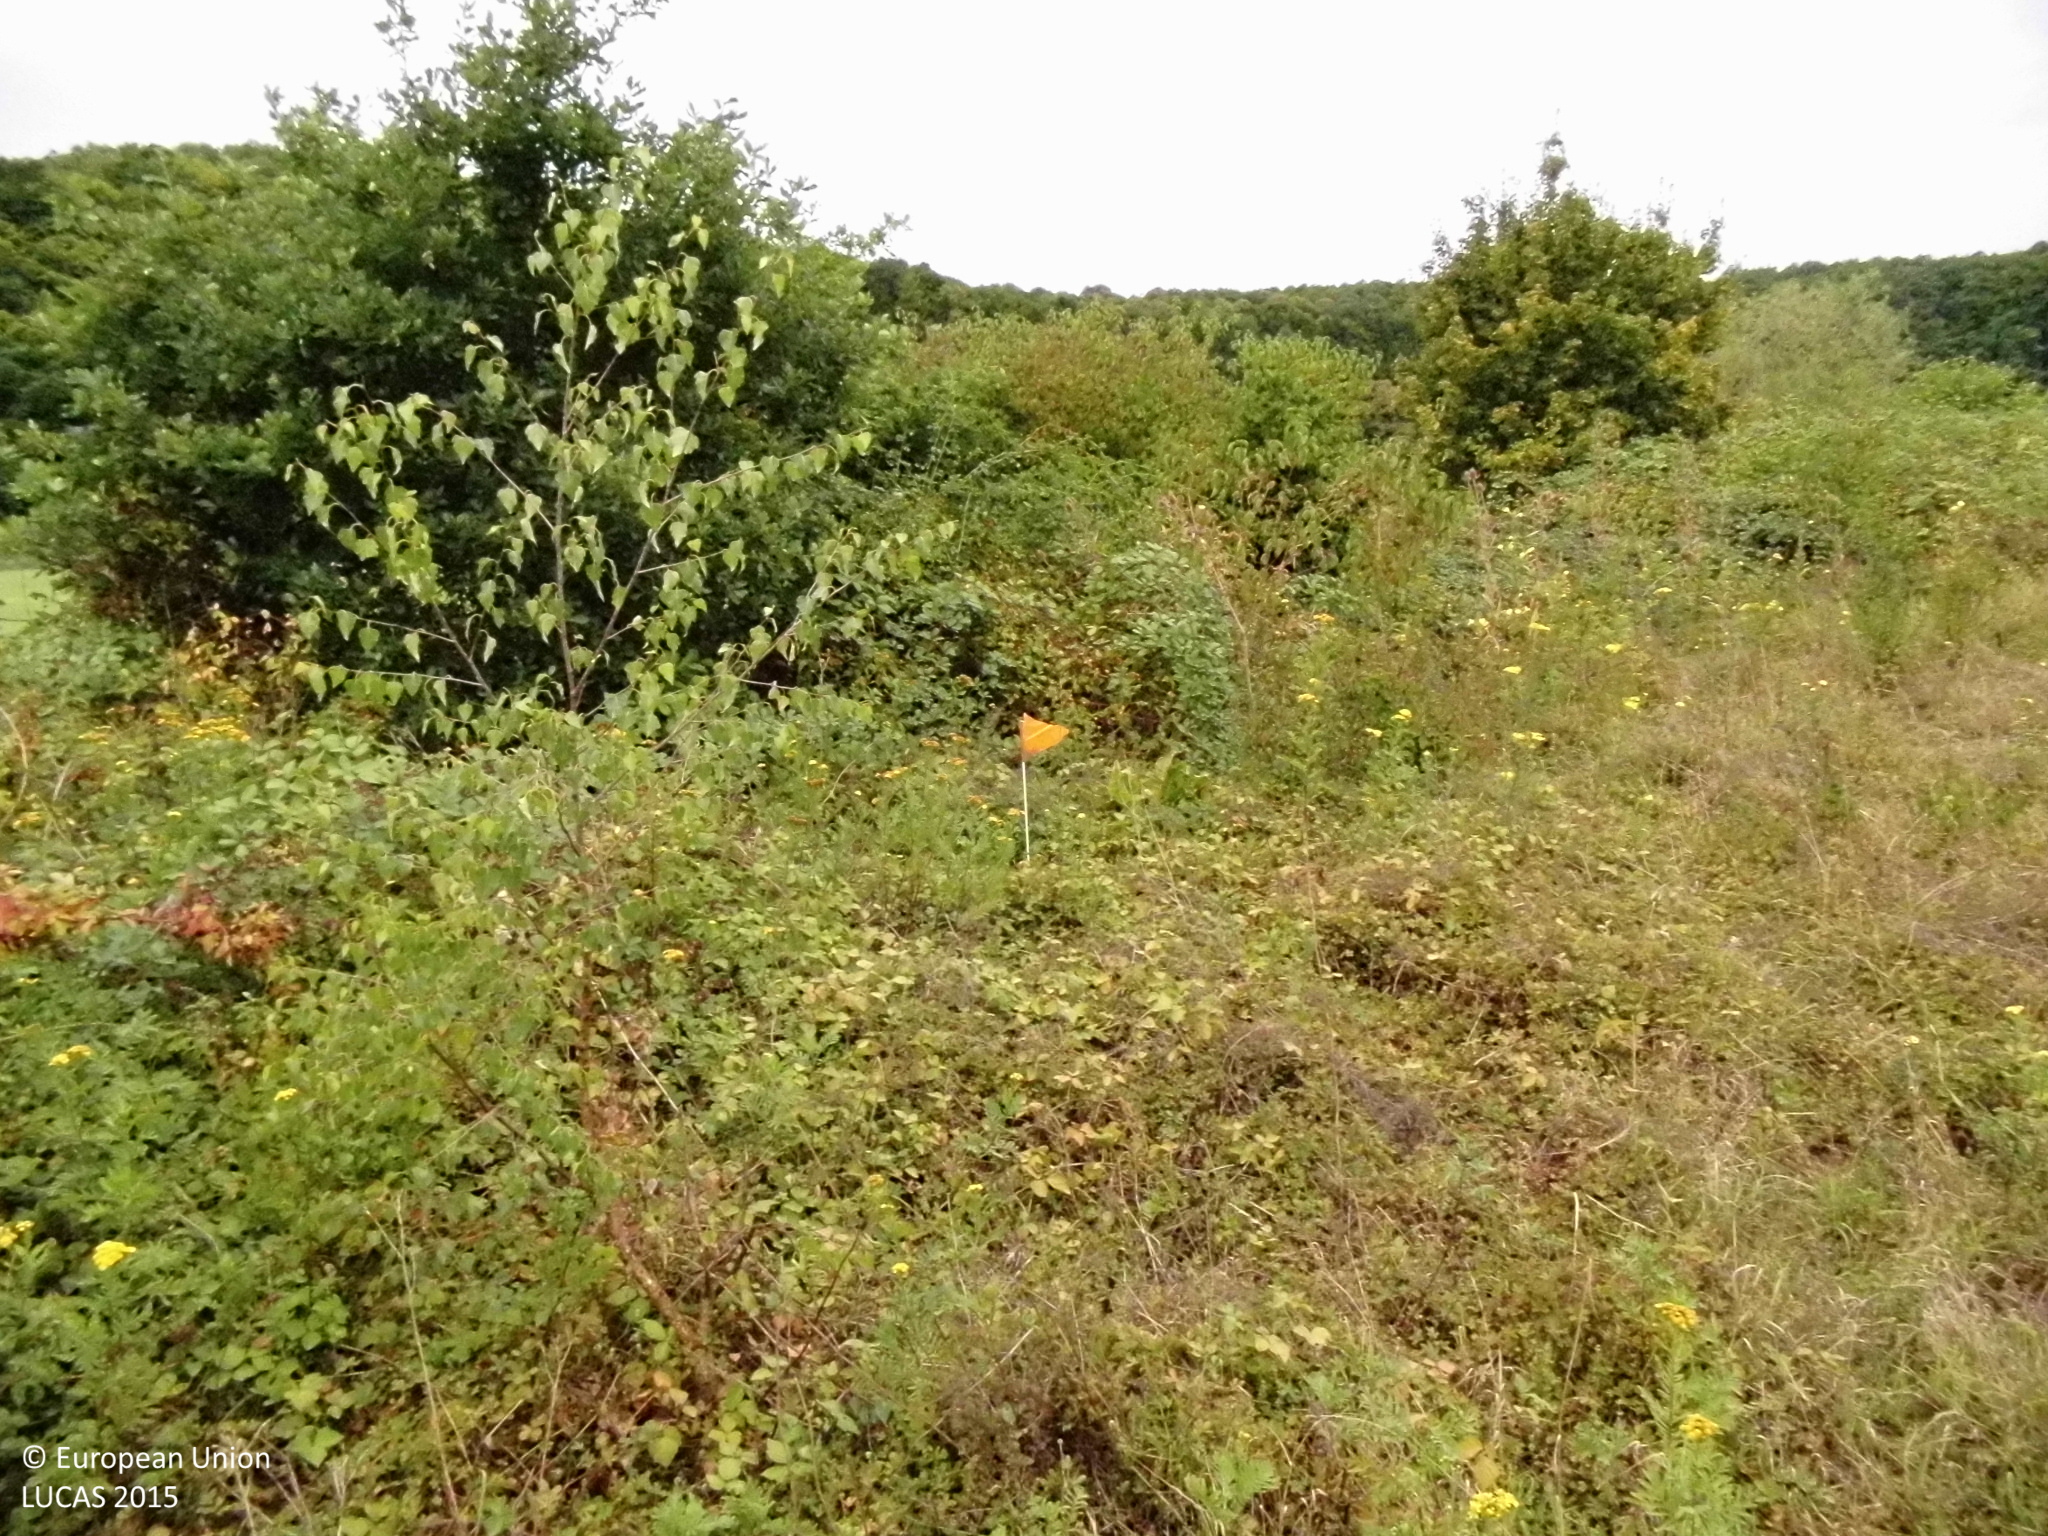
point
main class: Shrubland
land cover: Shrubland without tree cover
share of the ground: > 75 %
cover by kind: shrubs 90 %, herbaceous plants 10 %
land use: Semi-natural and natural areas not in use
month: August
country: DE
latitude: 50.4027
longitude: 8.1292
